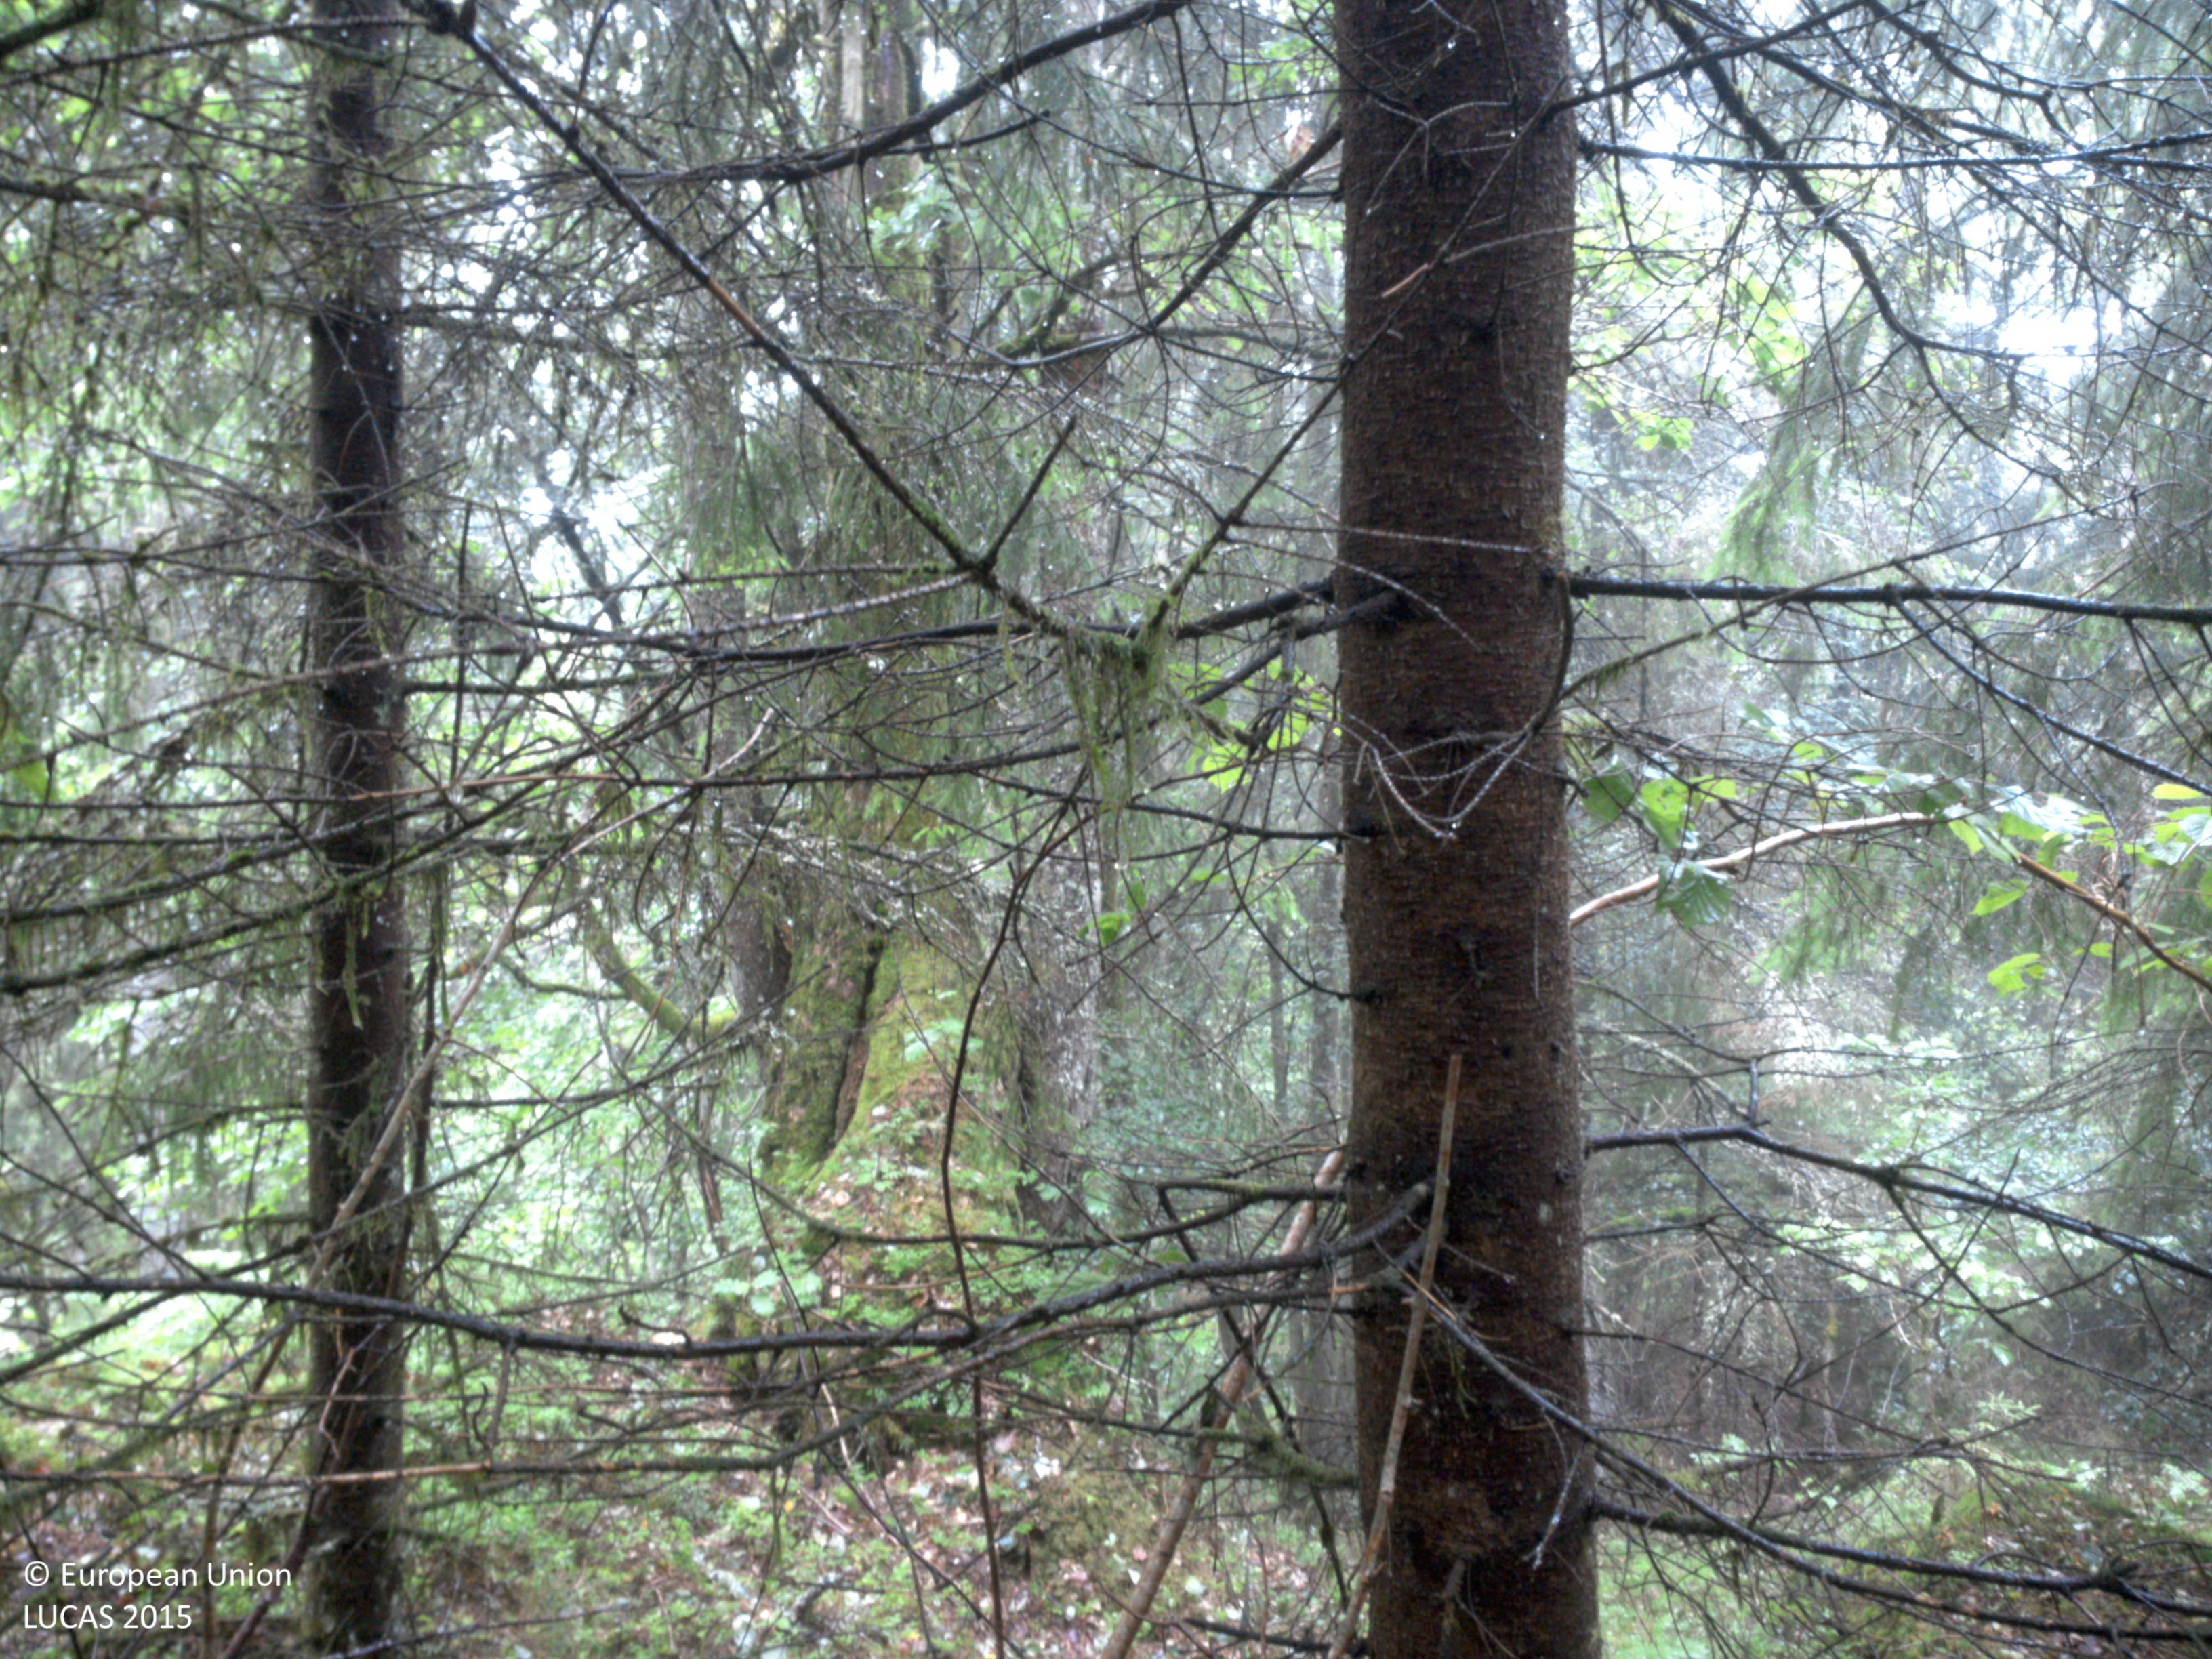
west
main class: Woodland
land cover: Spruce dominated coniferous woodland
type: boreal forest
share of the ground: > 75 %
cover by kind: coniferous forest trees 90 %, lichens and mosses 10 %
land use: Semi-natural and natural areas not in use
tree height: > 5 m
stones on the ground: < 10 %
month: July
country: SE
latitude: 58.6347
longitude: 12.1142
